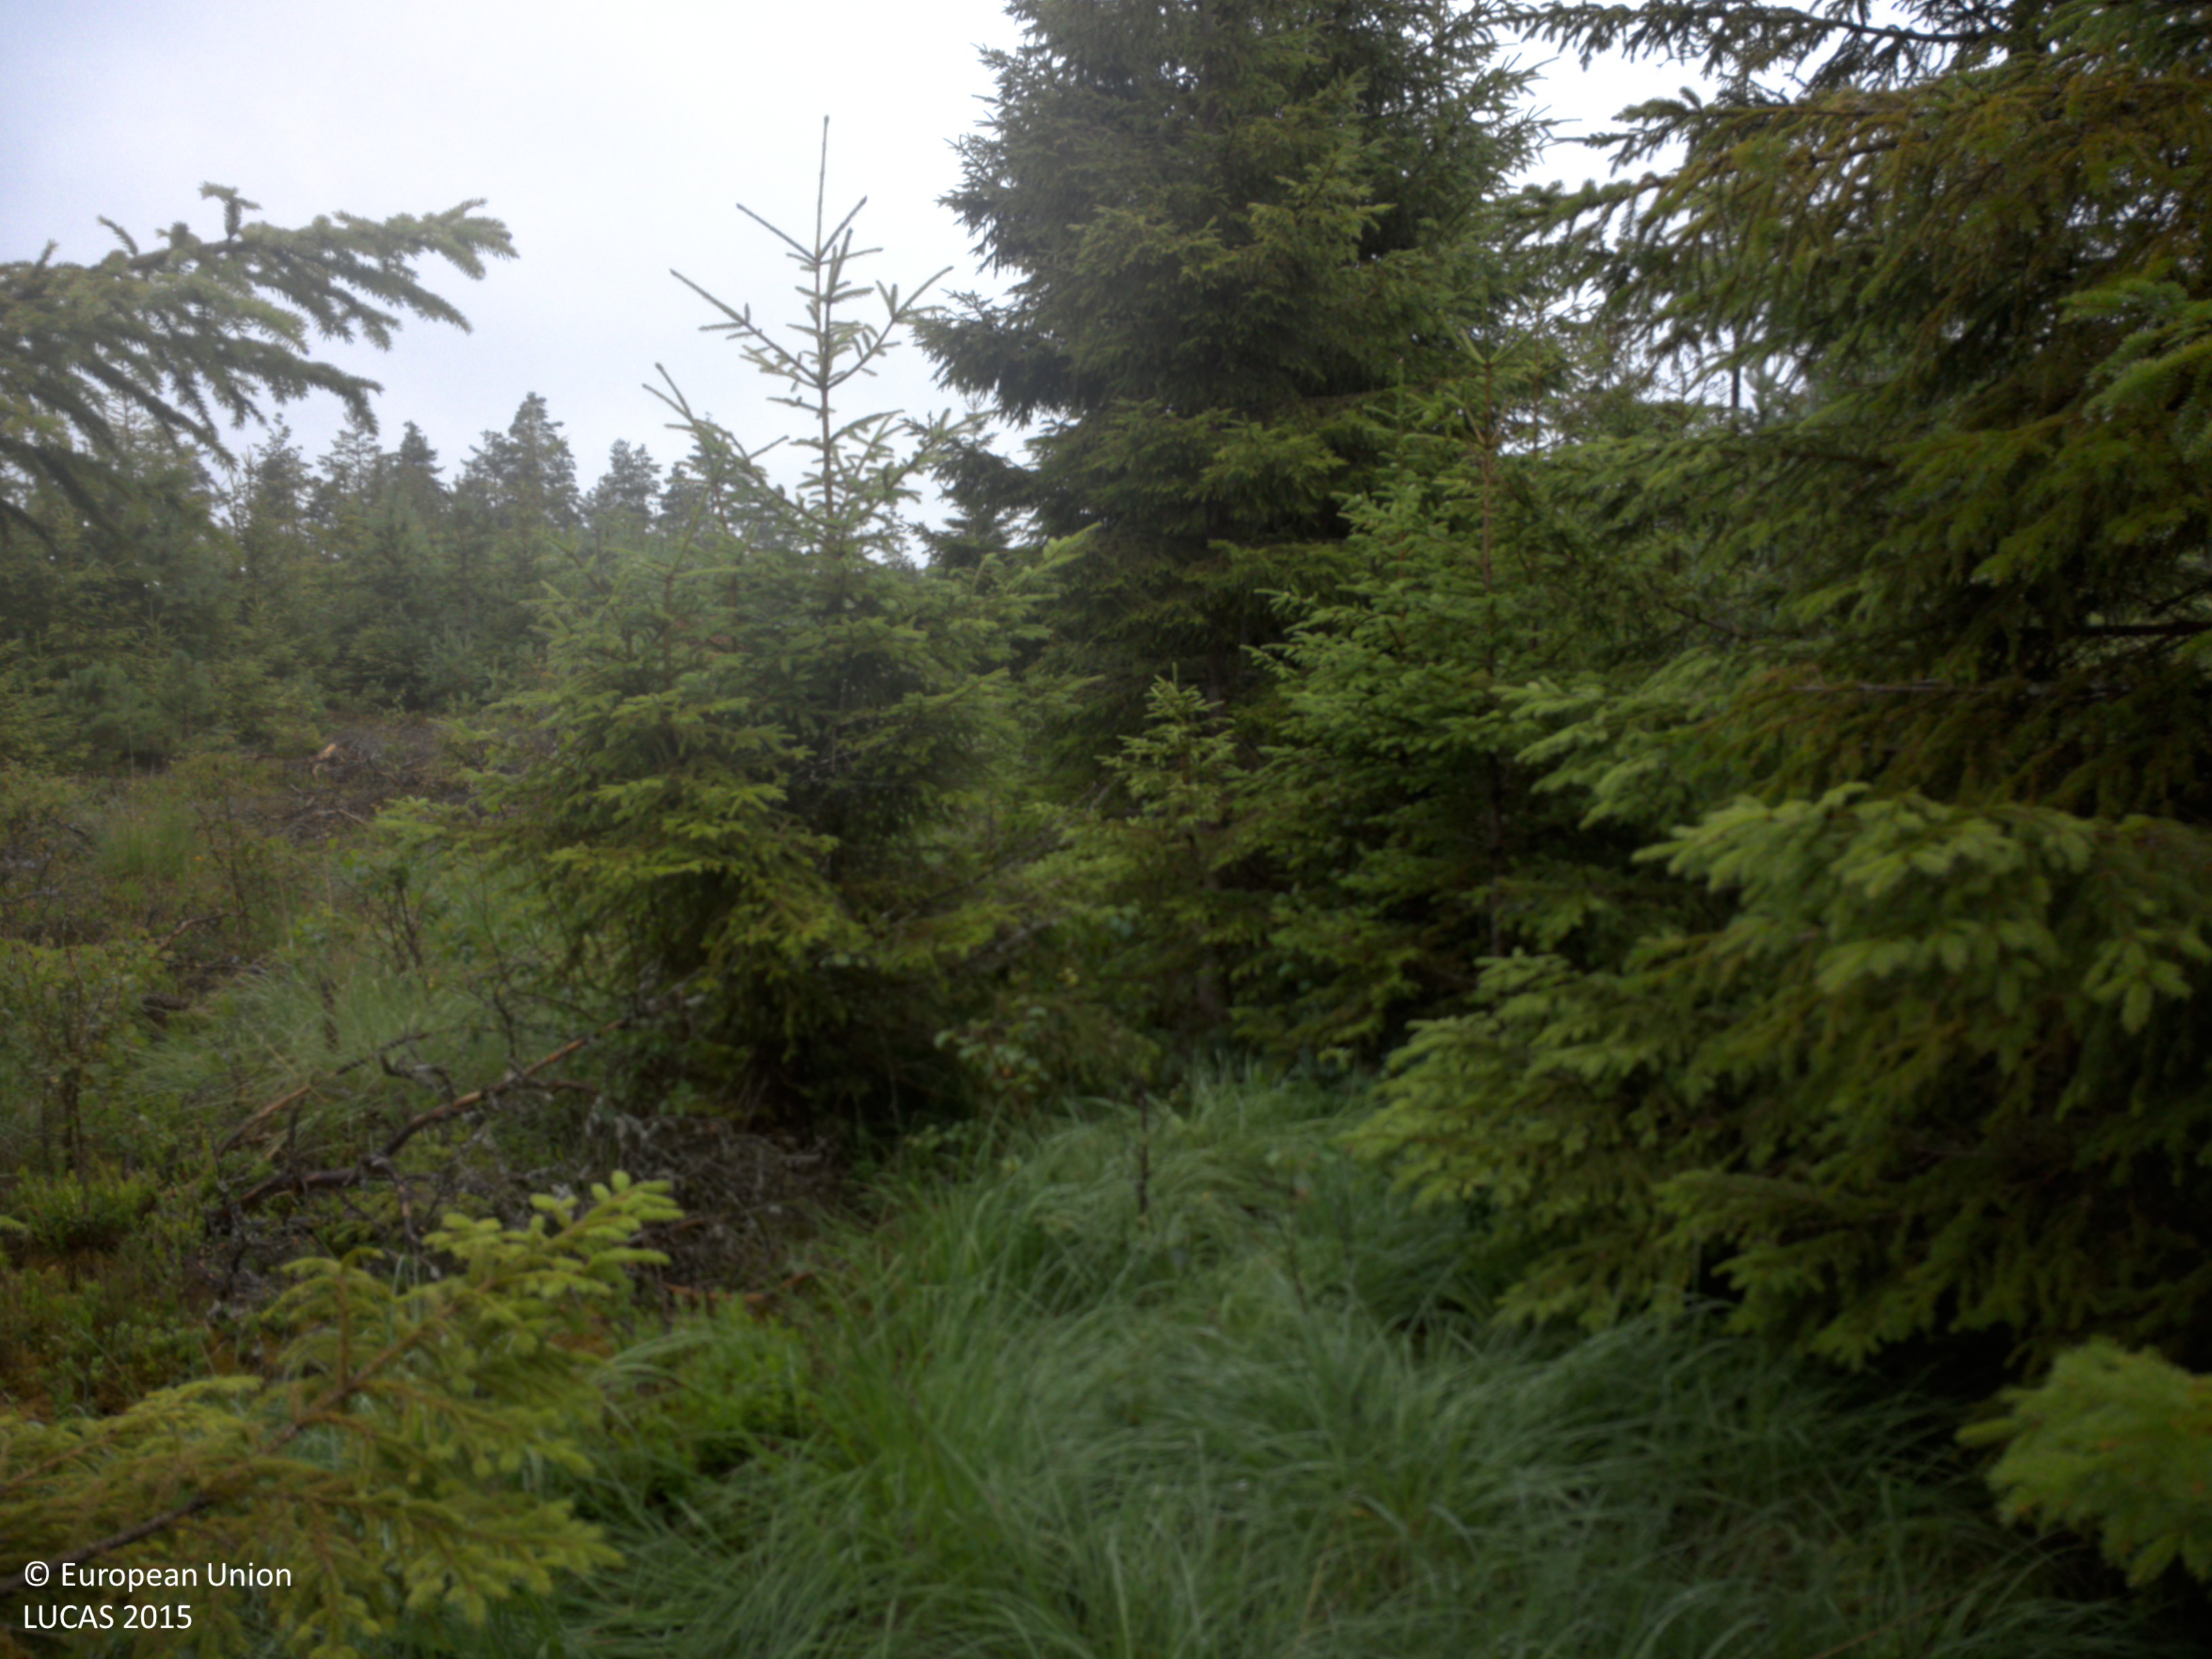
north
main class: Woodland
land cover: Spruce dominated mixed woodland
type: boreal forest
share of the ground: 50 - 75 %
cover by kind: coniferous forest trees 40 %, shrubs 40 %, broadleaved forest trees 20 %
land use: Forestry
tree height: > 5 m
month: July
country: SE
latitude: 58.6597
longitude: 11.5996
